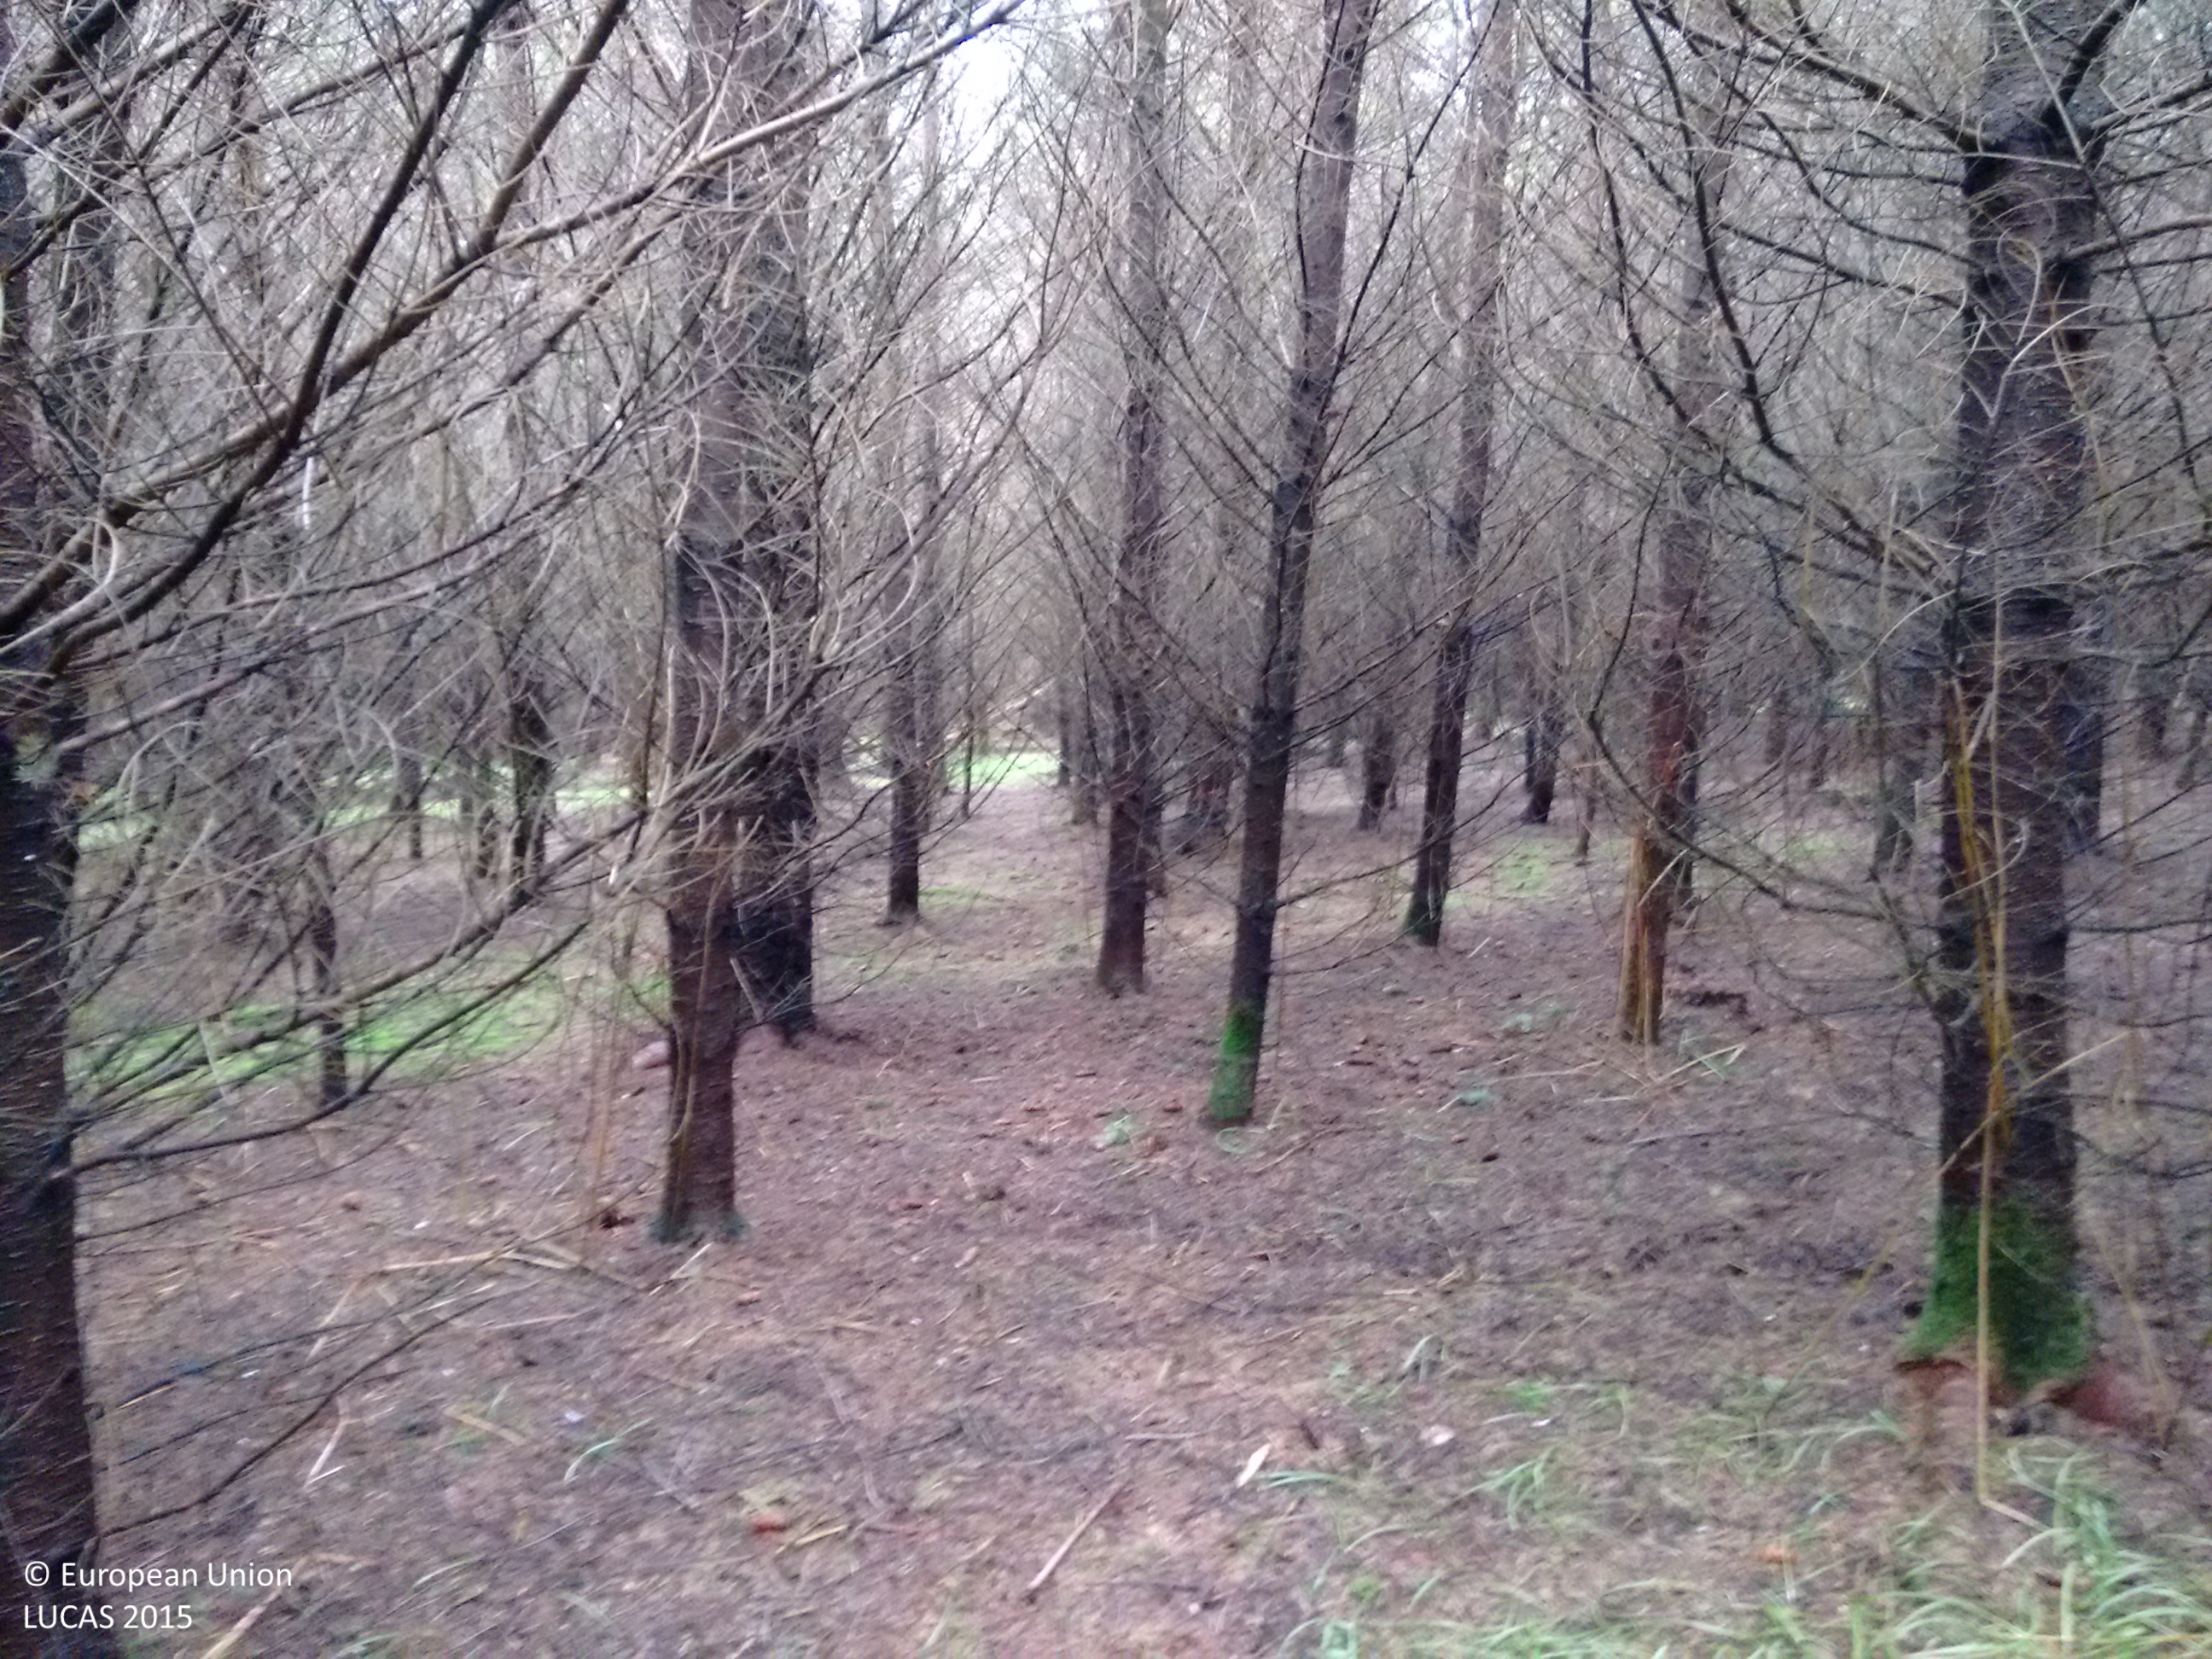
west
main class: Woodland
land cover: Spruce dominated coniferous woodland
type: exotic forest
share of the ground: > 75 %
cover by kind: coniferous forest trees 95 %, broadleaved forest trees 5 %
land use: Forestry
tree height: > 5 m
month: May
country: GB
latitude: 50.8711
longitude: -2.0381
